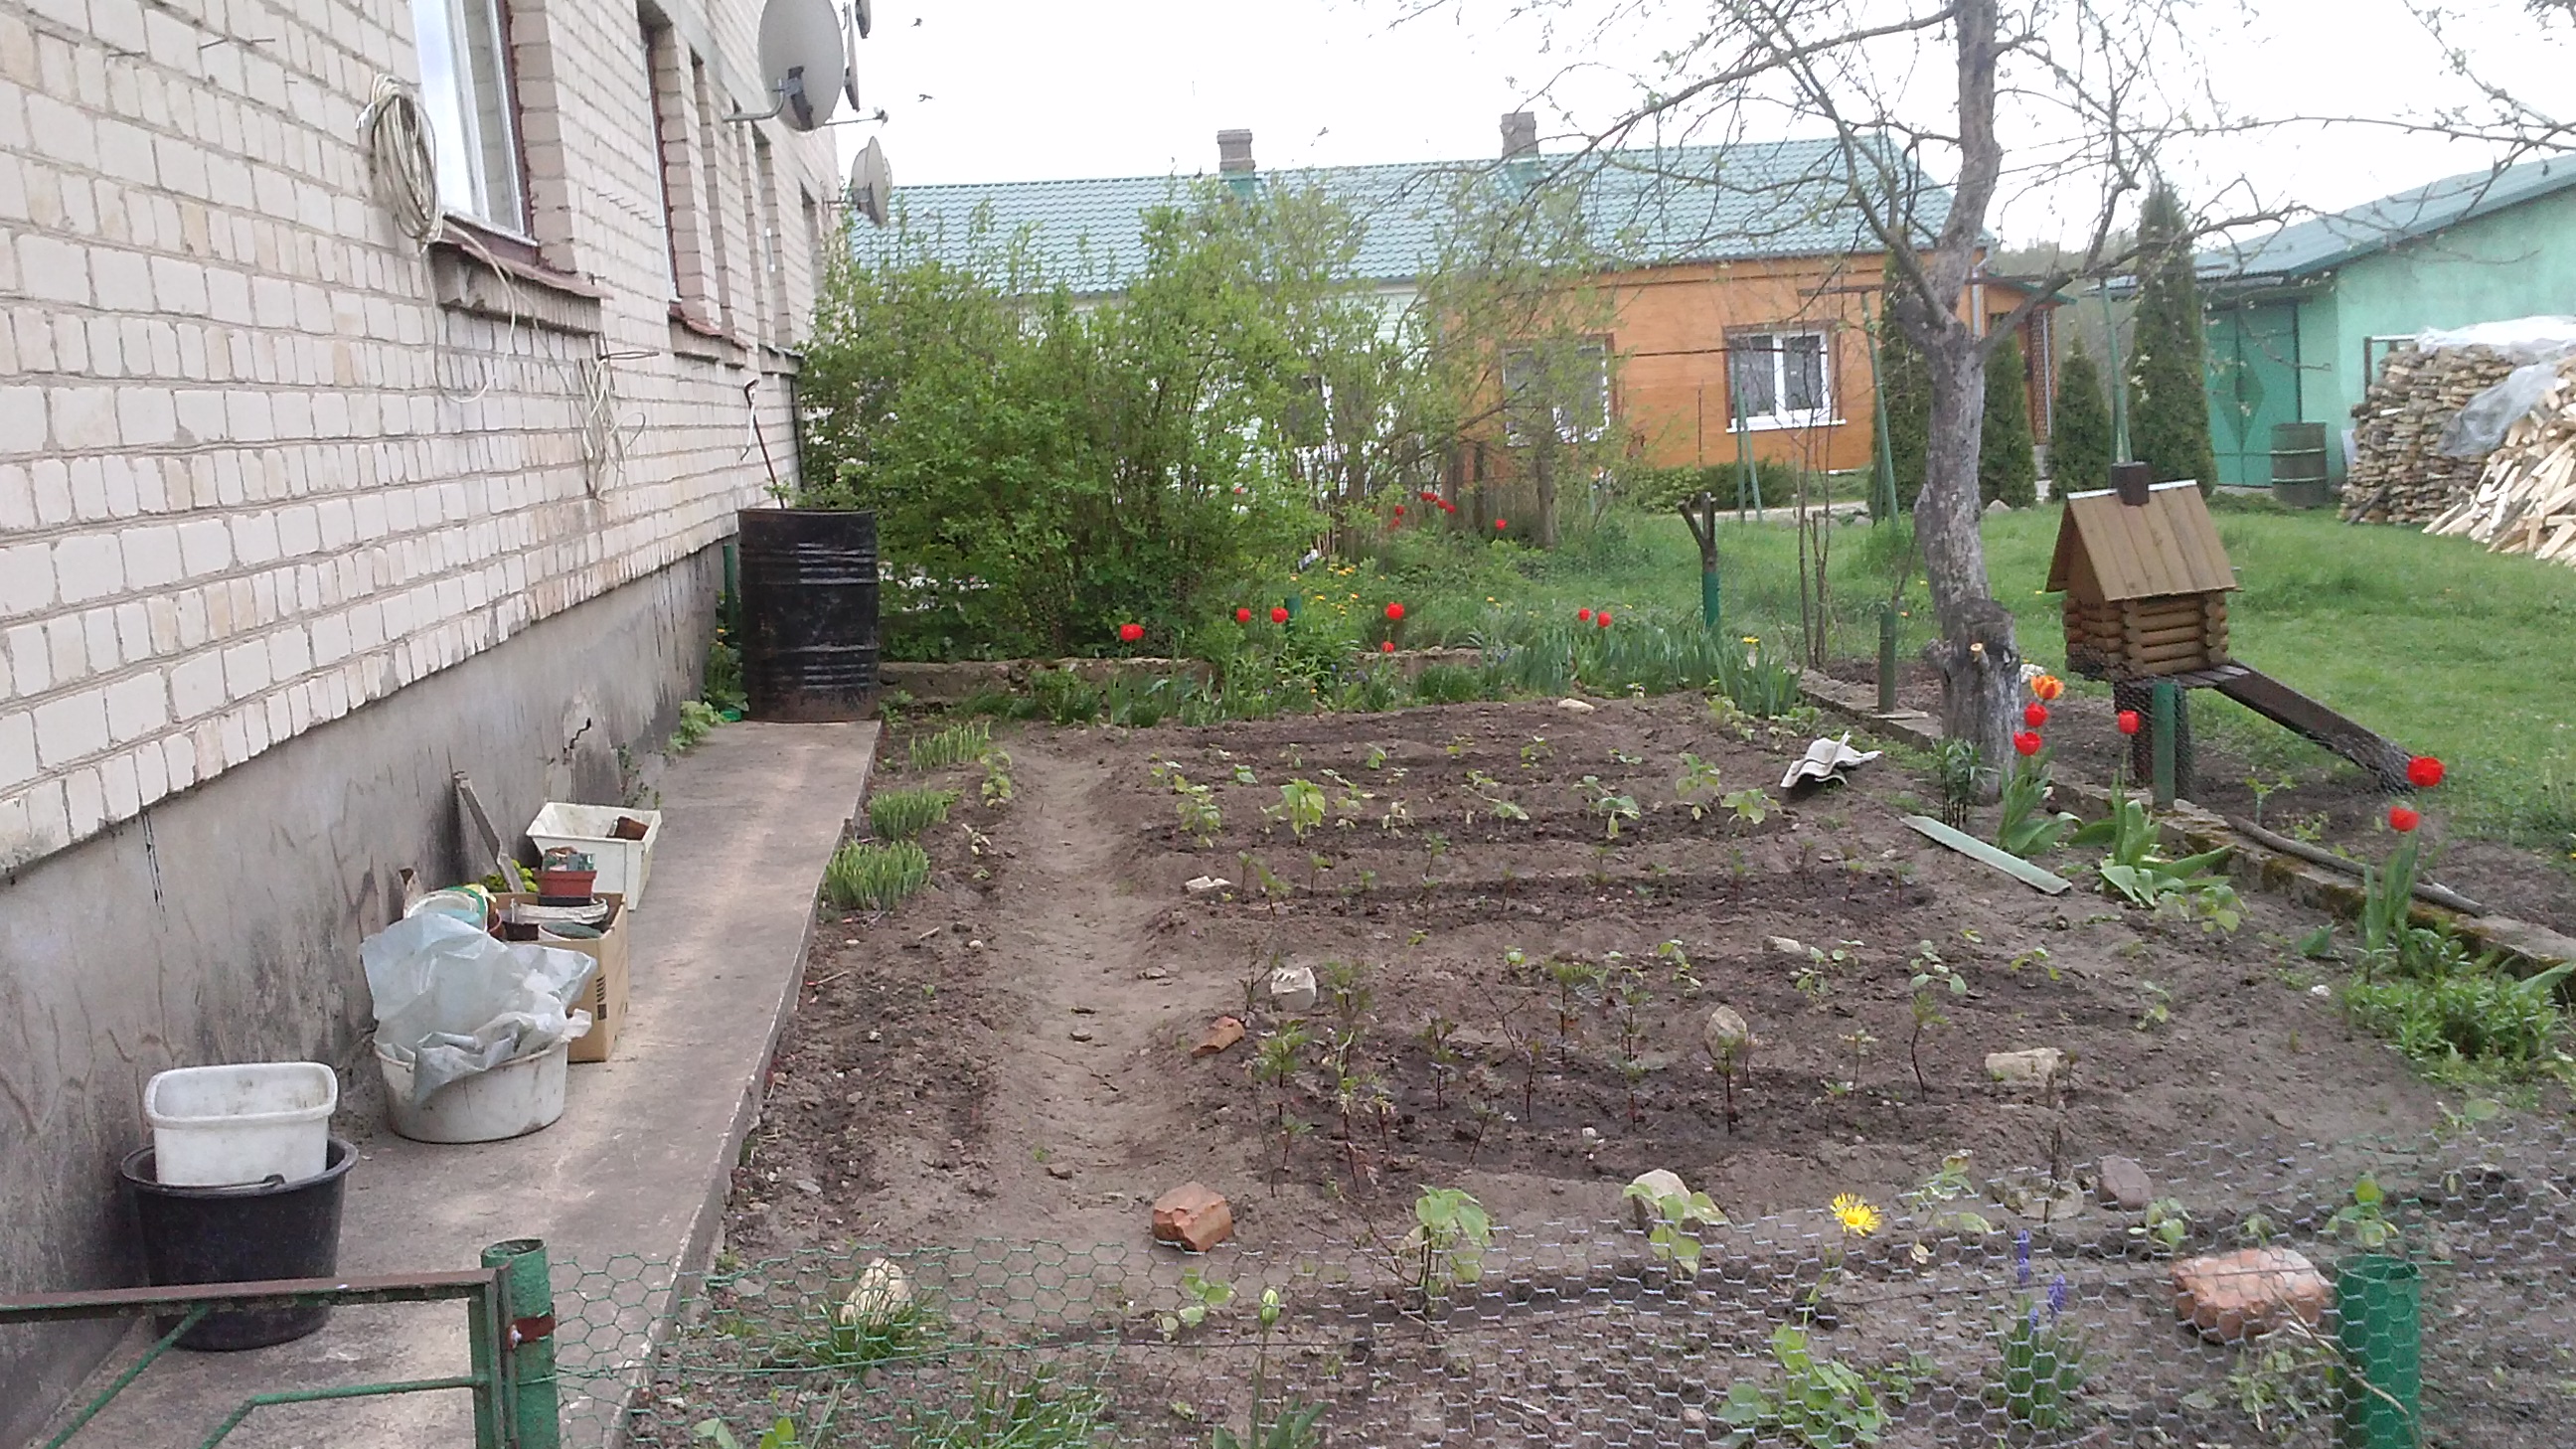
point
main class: Cropland
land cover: Floriculture and ornamental plants
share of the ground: > 75 %
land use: Kitchen garden
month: May
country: LV
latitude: 55.9231
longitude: 27.1496
